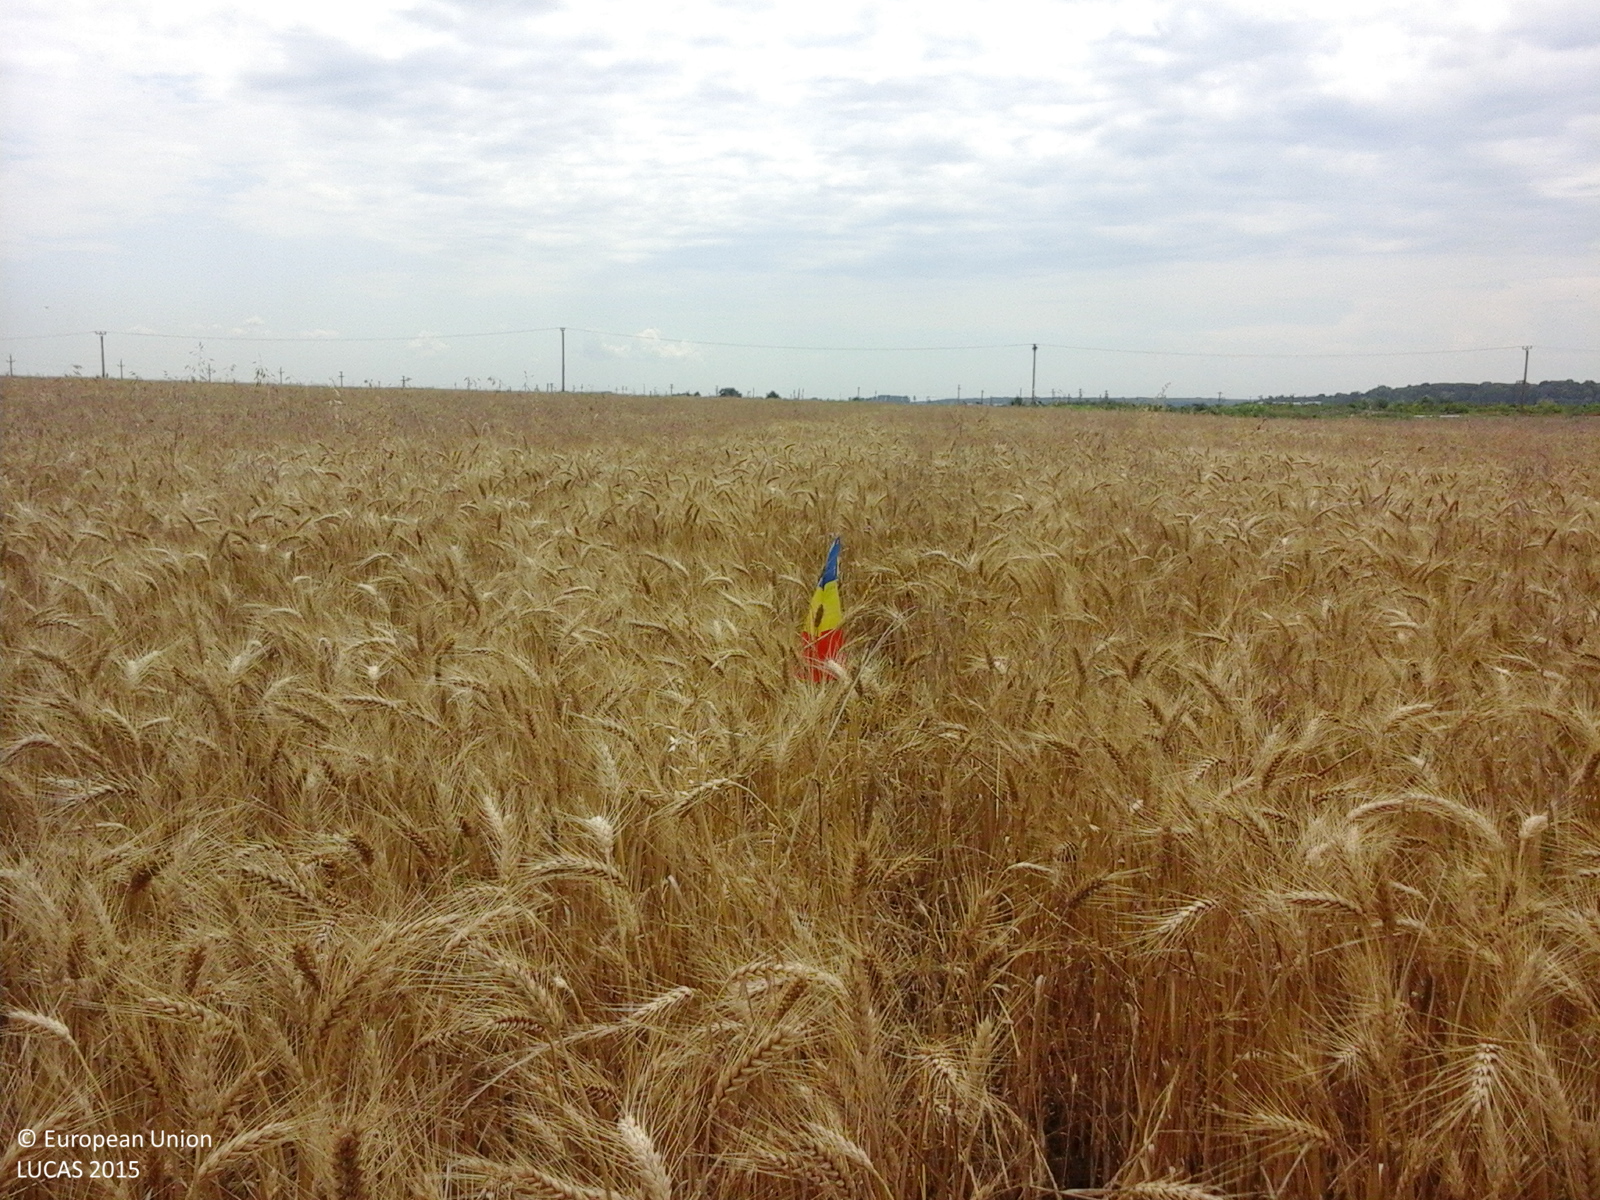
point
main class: Cropland
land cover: Common wheat
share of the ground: > 75 %
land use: Agriculture (excluding fallow land and kitchen gardens)
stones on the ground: < 10 %
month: June
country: RO
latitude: 44.4065
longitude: 25.8580
